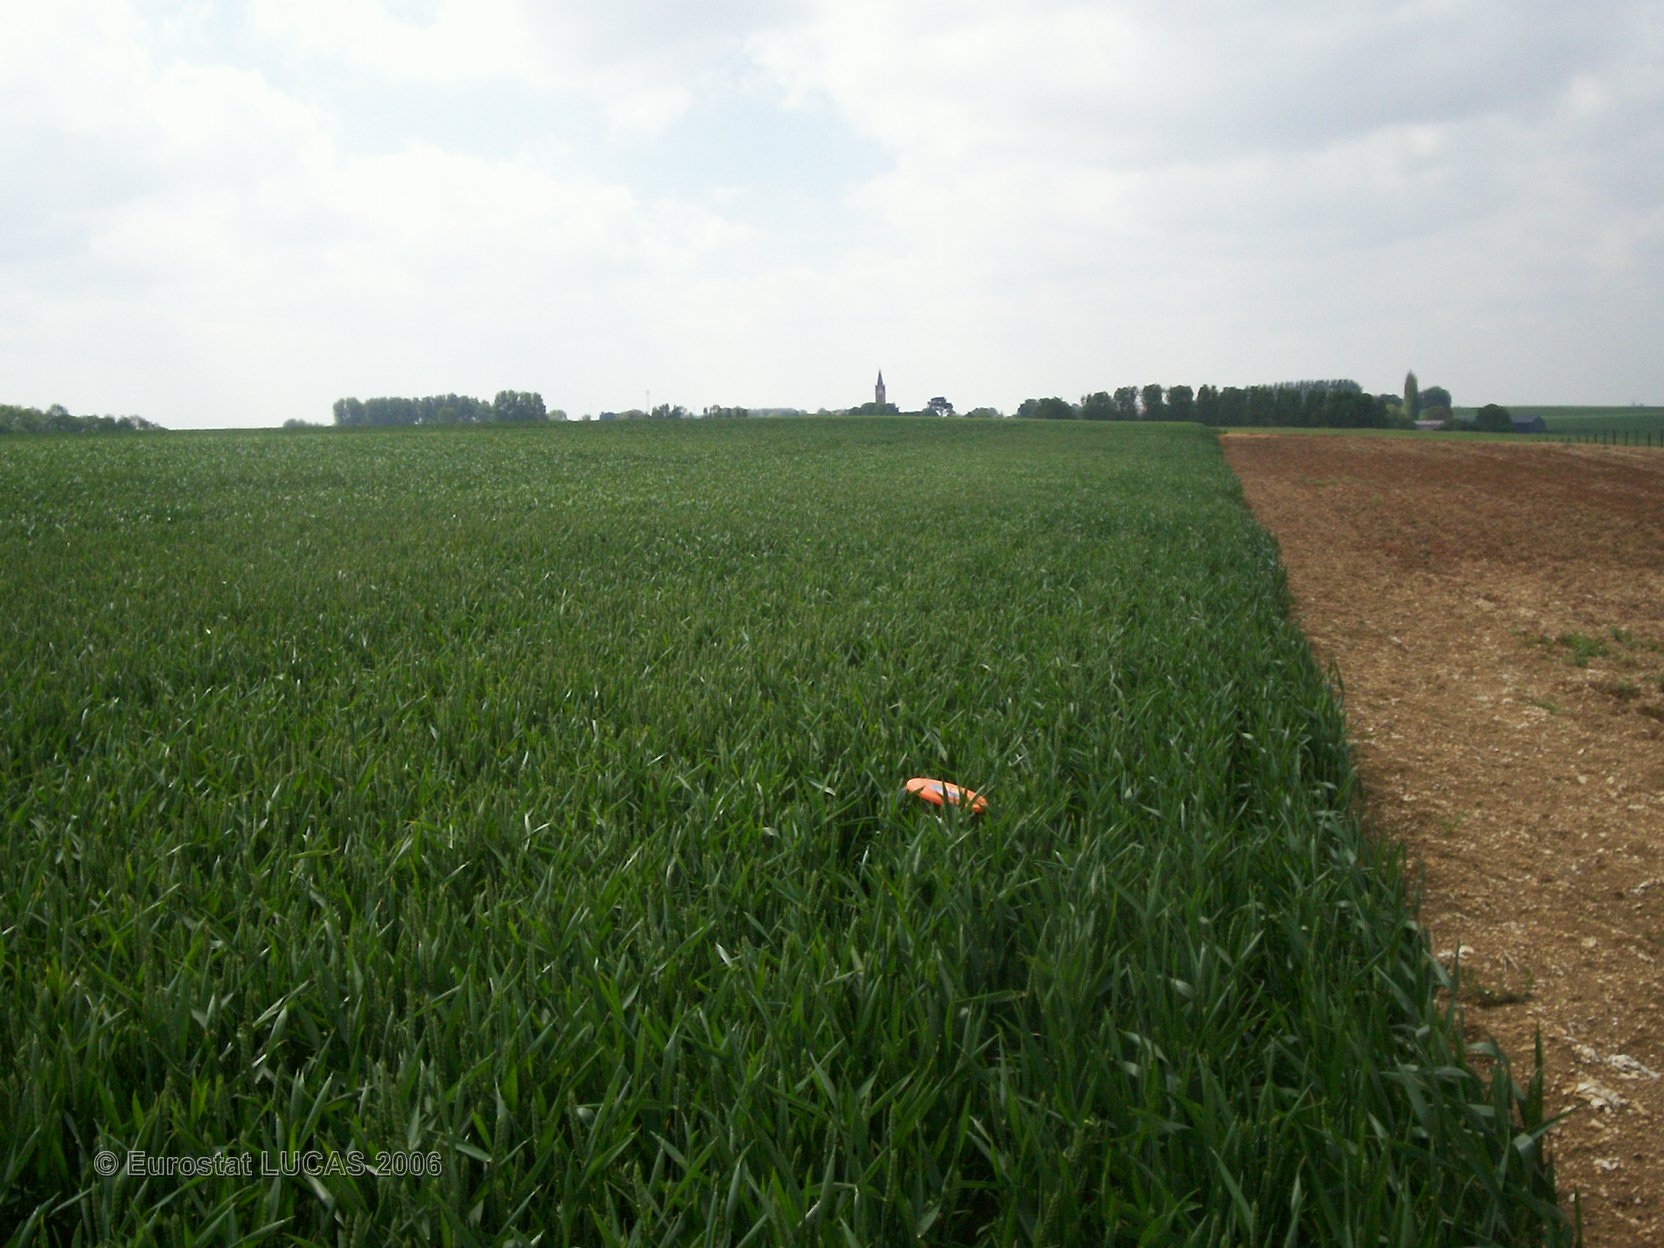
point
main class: Cropland
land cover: Common wheat
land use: Agriculture (excluding fallow land and kitchen gardens)
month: June
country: FR
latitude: 49.8965
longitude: 2.7080
